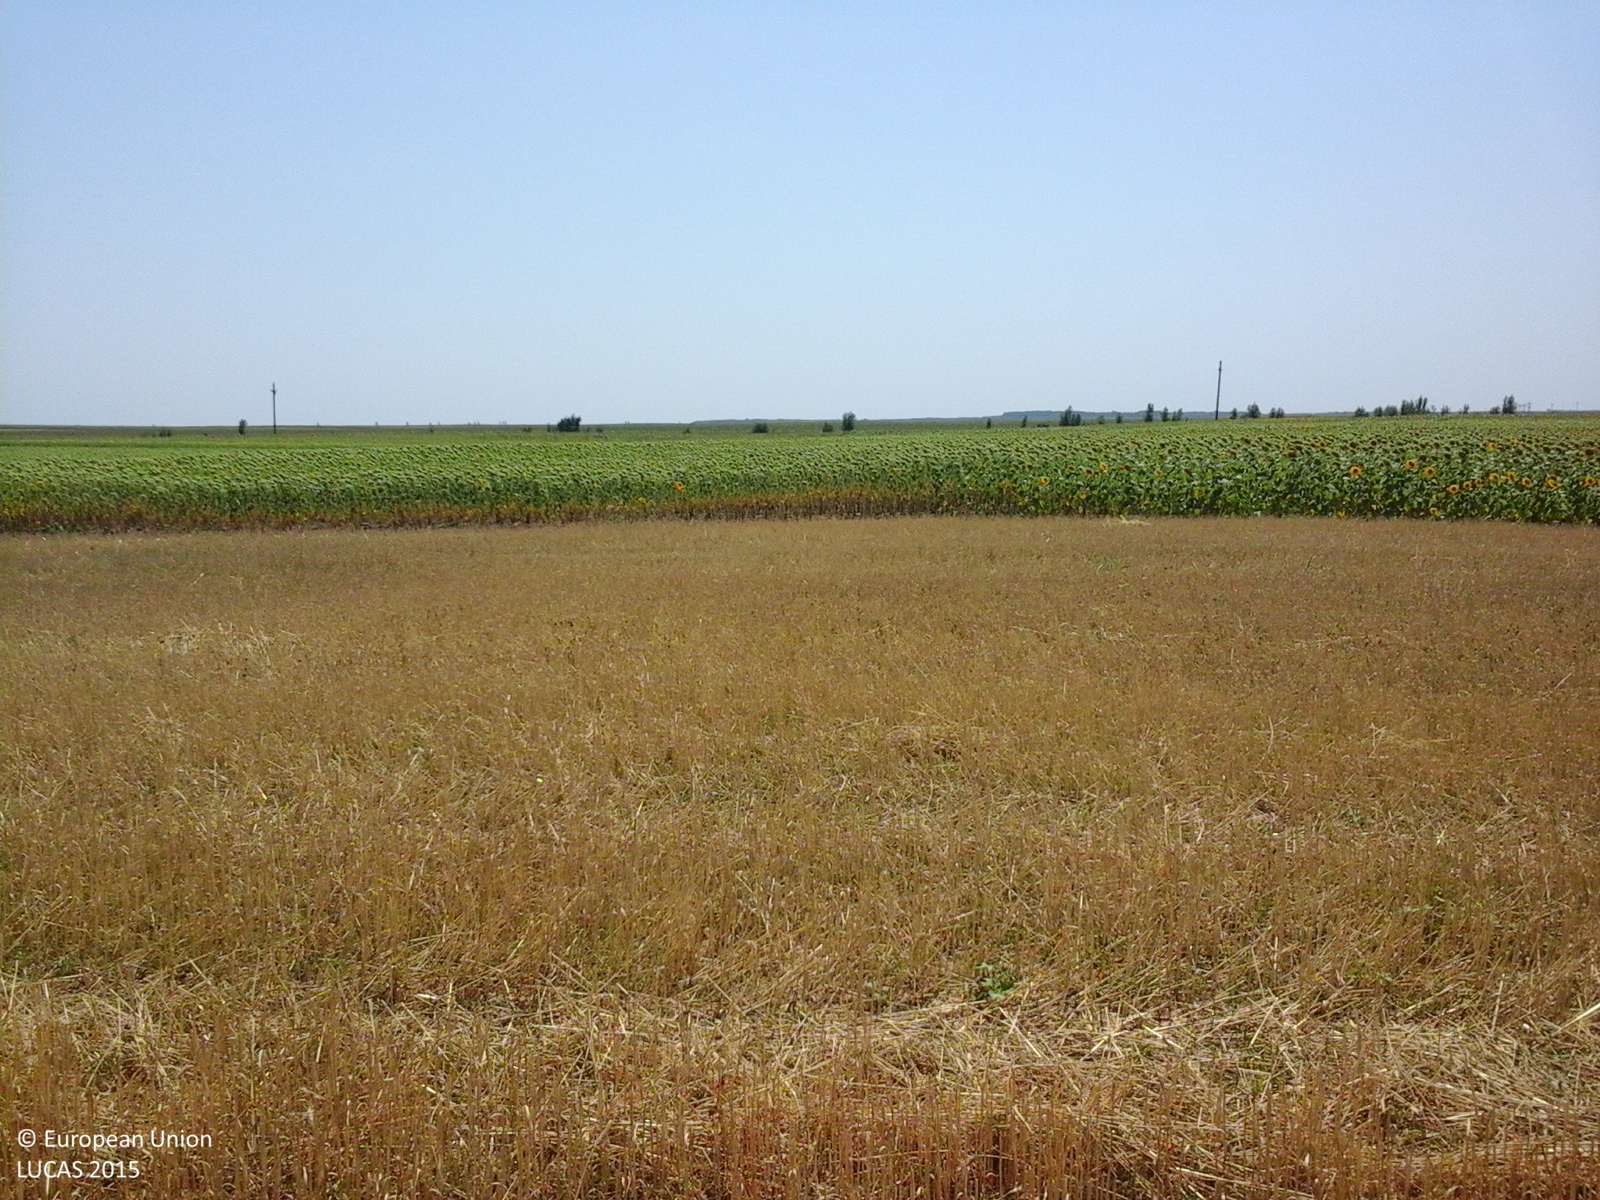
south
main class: Cropland
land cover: Maize
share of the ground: > 75 %
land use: Agriculture (excluding fallow land and kitchen gardens)
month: July
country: RO
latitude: 44.9003
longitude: 27.3533
